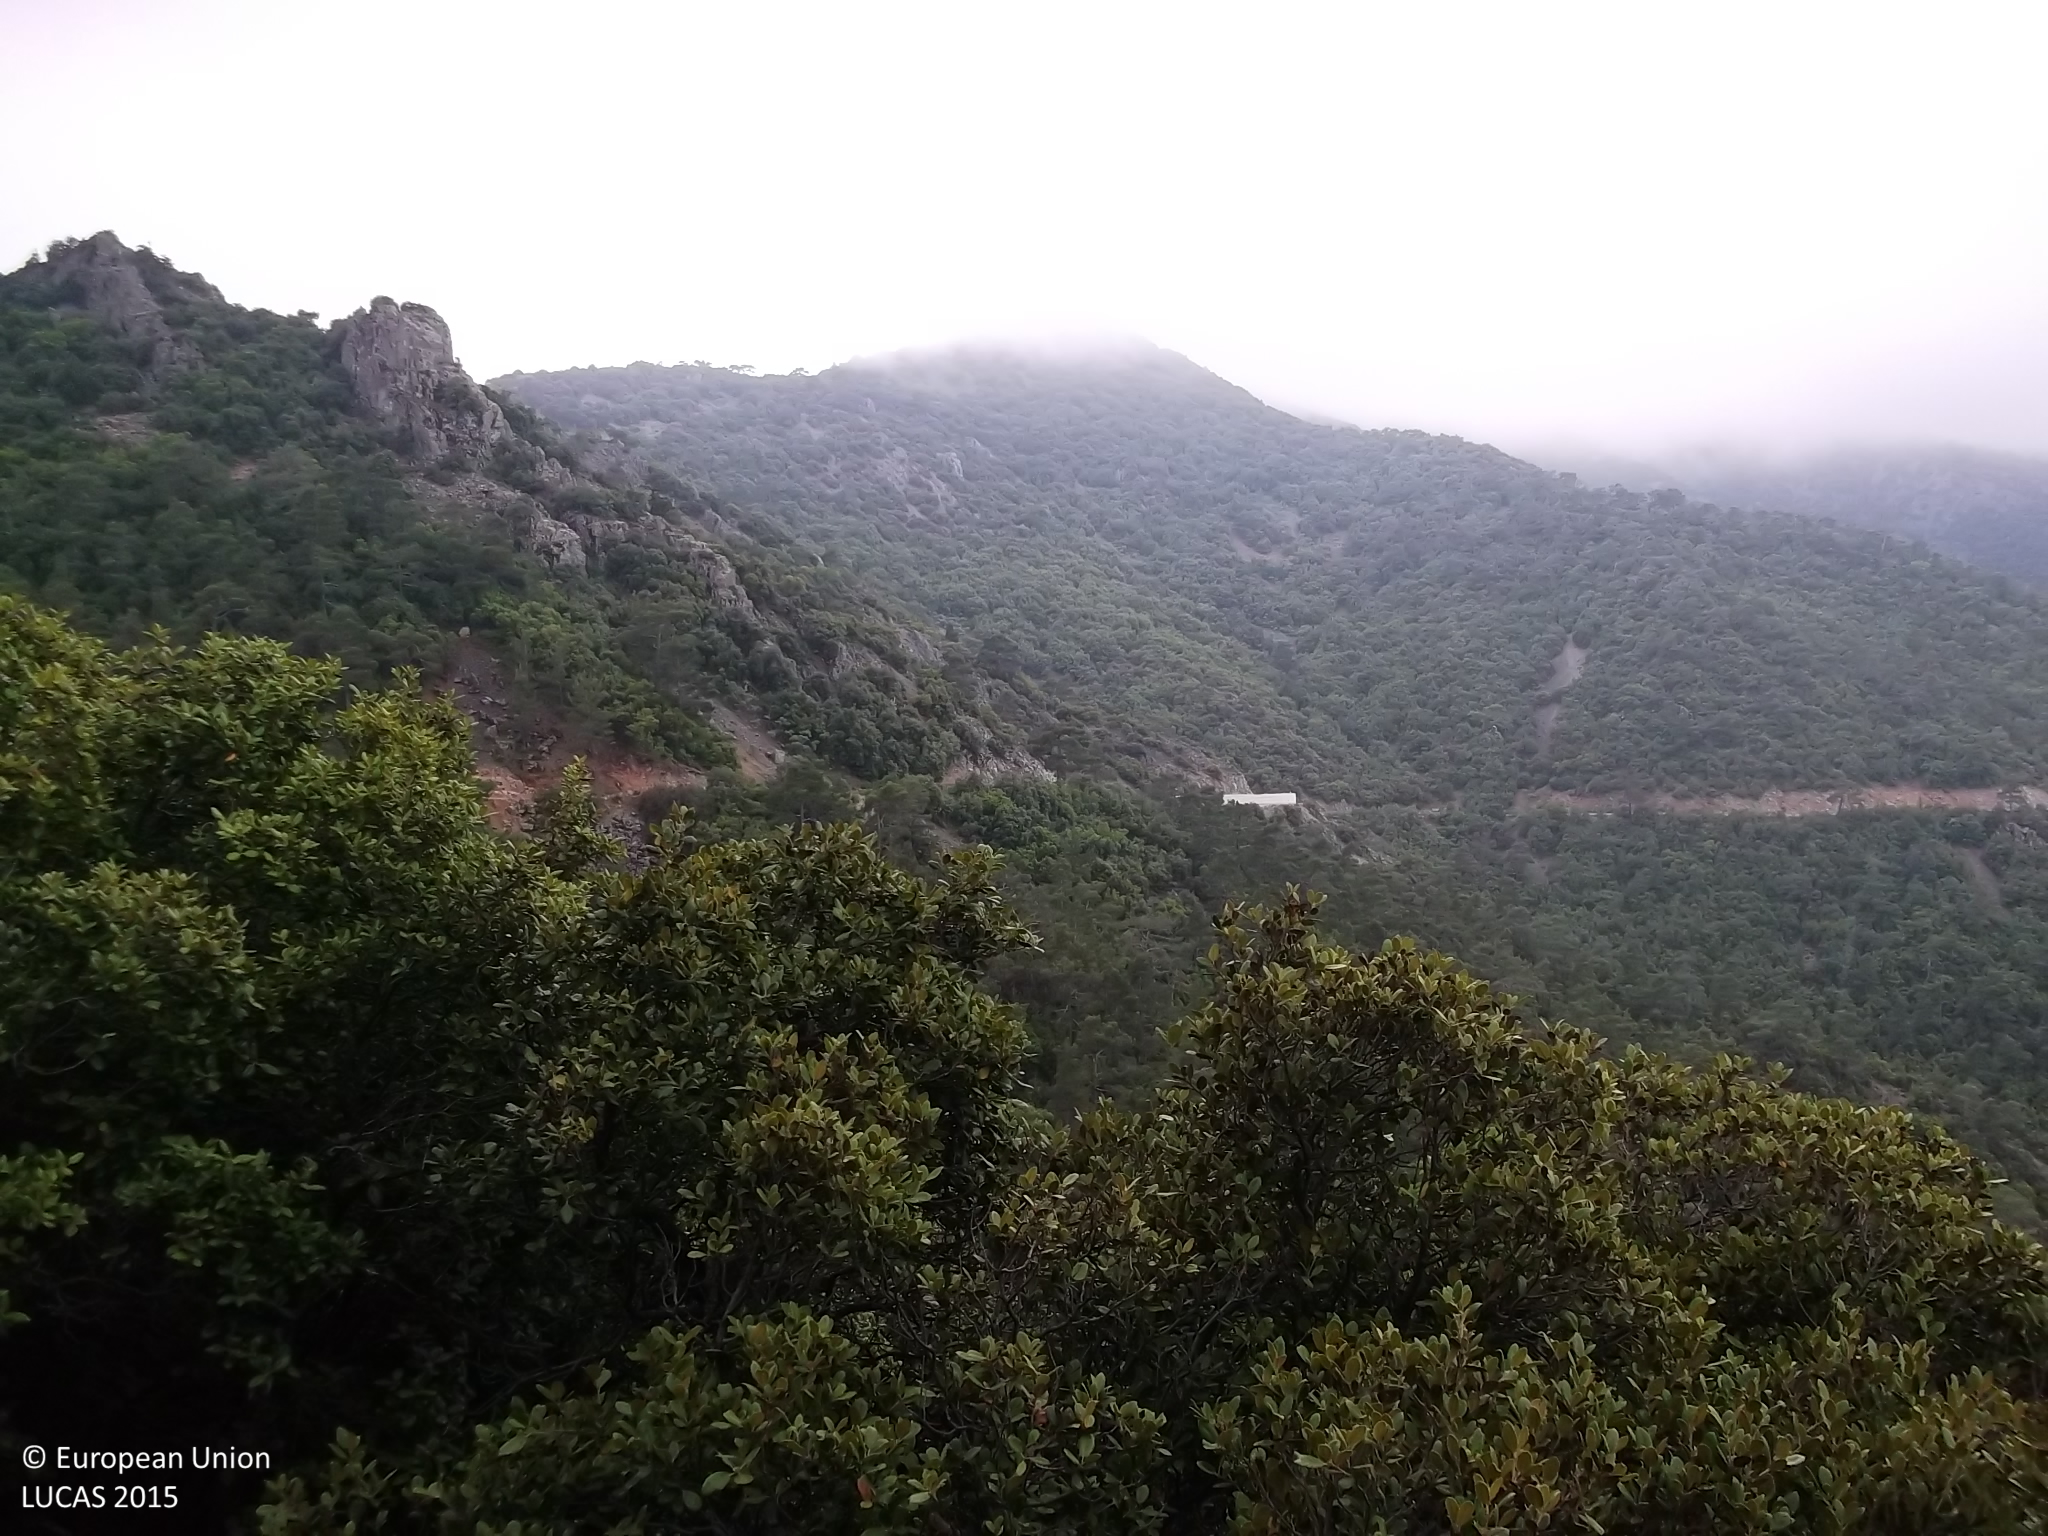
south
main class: Woodland
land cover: Pine dominated mixed woodland
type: coniferous forest of the mediterranean region
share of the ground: > 75 %
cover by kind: coniferous forest trees 60 %, broadleaved forest trees 20 %, shrubs 10 %, unconsolidated bare surface 10 %
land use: Forestry
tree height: > 5 m
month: June
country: CY
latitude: 34.9664
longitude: 32.9858
